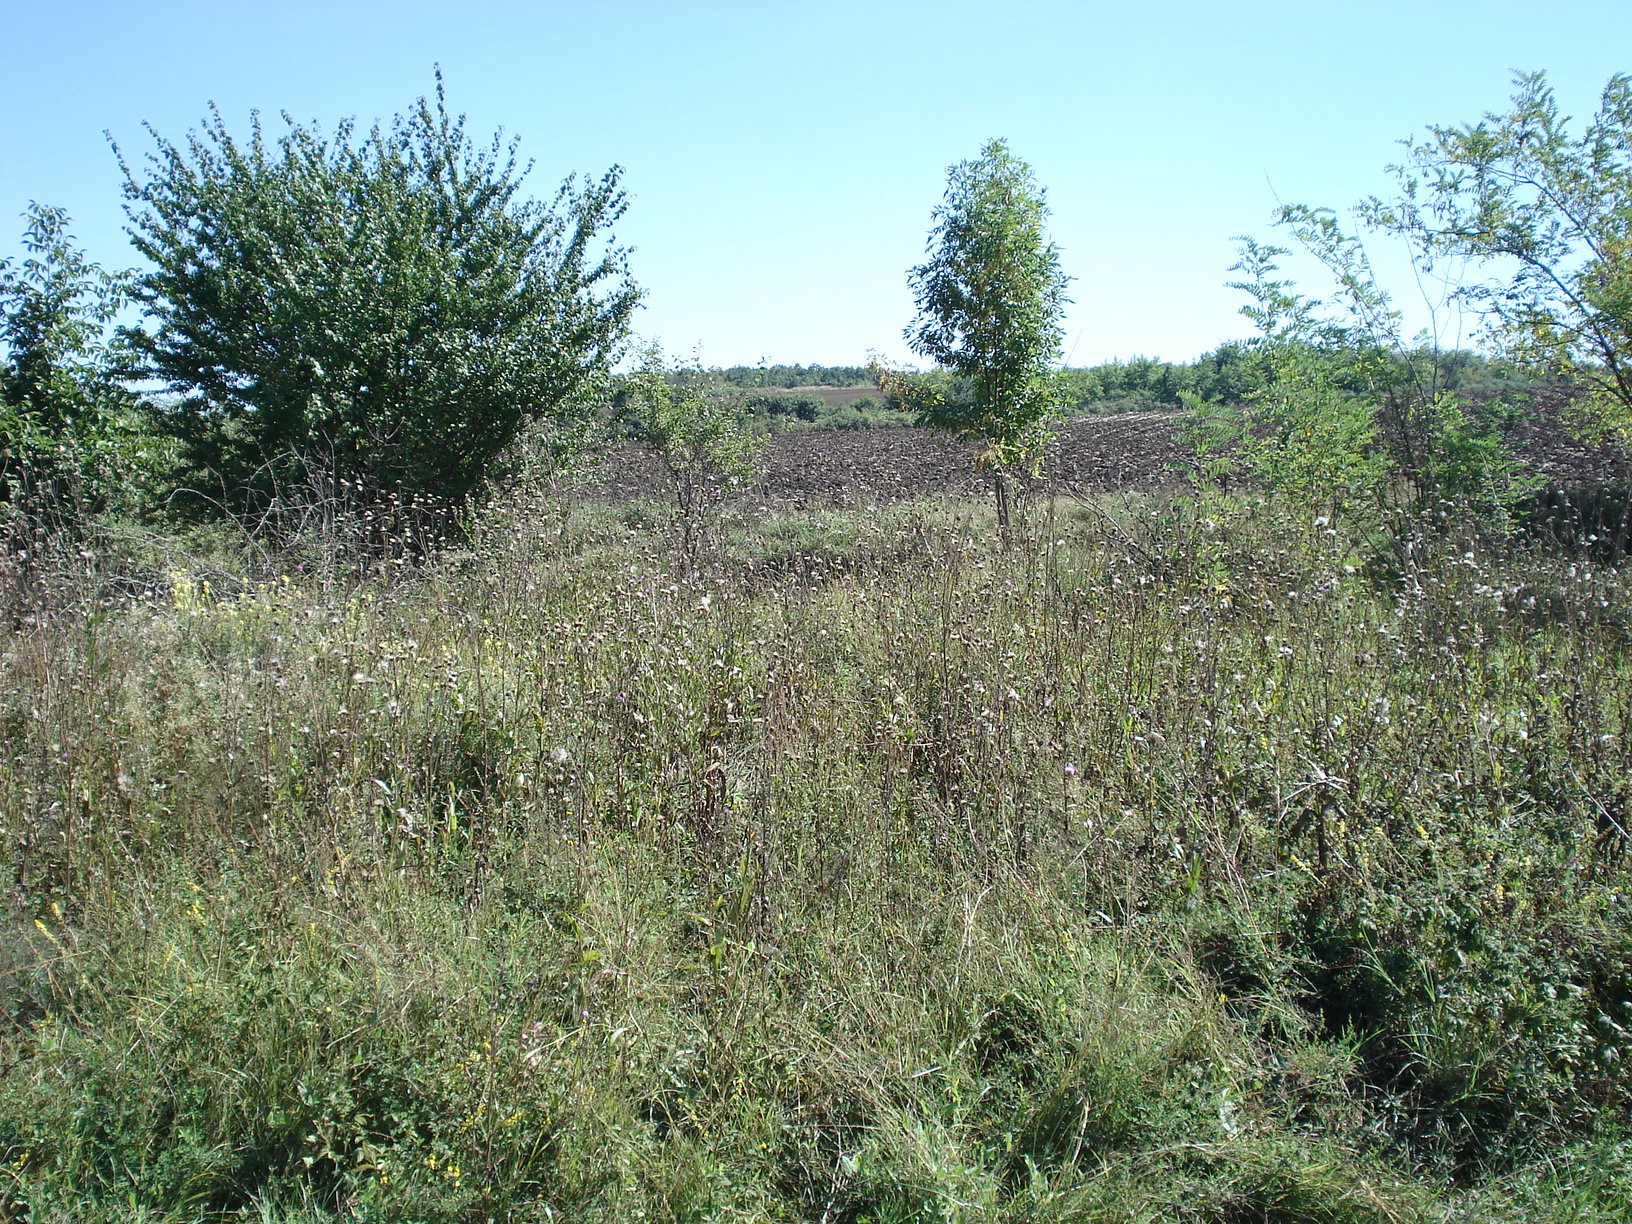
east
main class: Grassland
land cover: Grassland without tree/shrub cover
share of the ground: > 75 %
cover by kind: herbaceous plants 100 %
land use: Semi-natural and natural areas not in use
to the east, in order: Grassland without tree/shrub cover; Spontaneously vegetated surfaces; Shrubland with sparse tree cover; Ditches and canals; Abandoned hedges; Tracks; Grass margins; Abandoned hedges; Ditches and canals; Shrubland with sparse tree cover
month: September
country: BG
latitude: 43.2895
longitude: 25.2457
